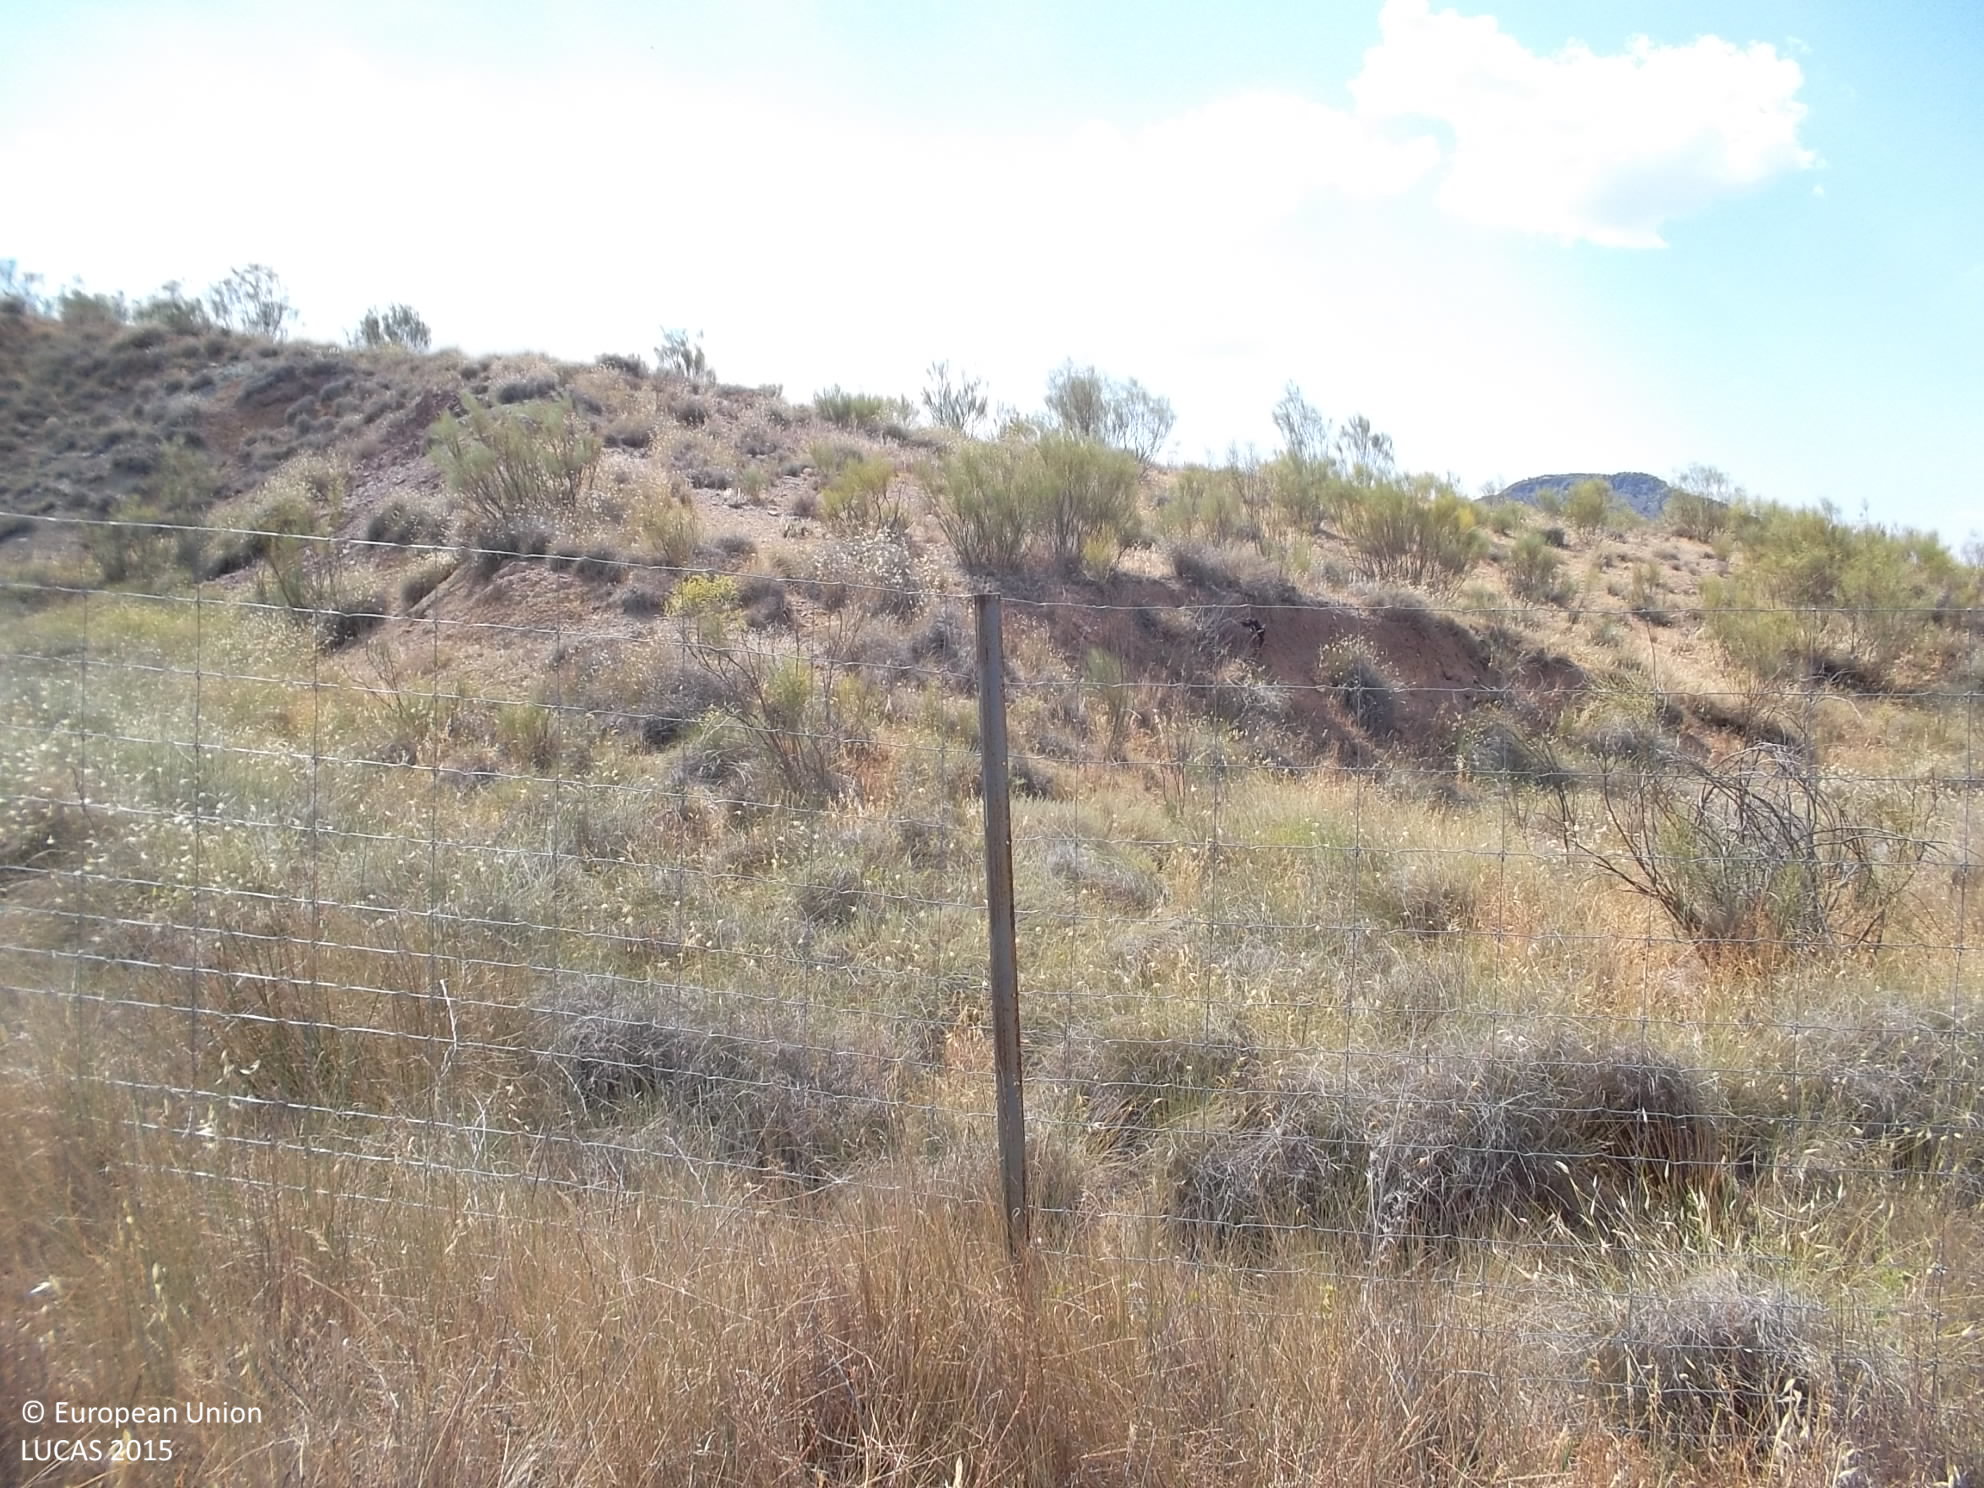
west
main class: Grassland
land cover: Grassland with sparse tree/shrub cover
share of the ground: > 75 %
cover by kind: herbaceous plants 85 %, shrubs 10 %, broadleaved forest trees 5 %
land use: Agriculture (excluding fallow land and kitchen gardens)
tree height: < 5 m
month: June
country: ES
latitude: 37.6847
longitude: -3.2041
